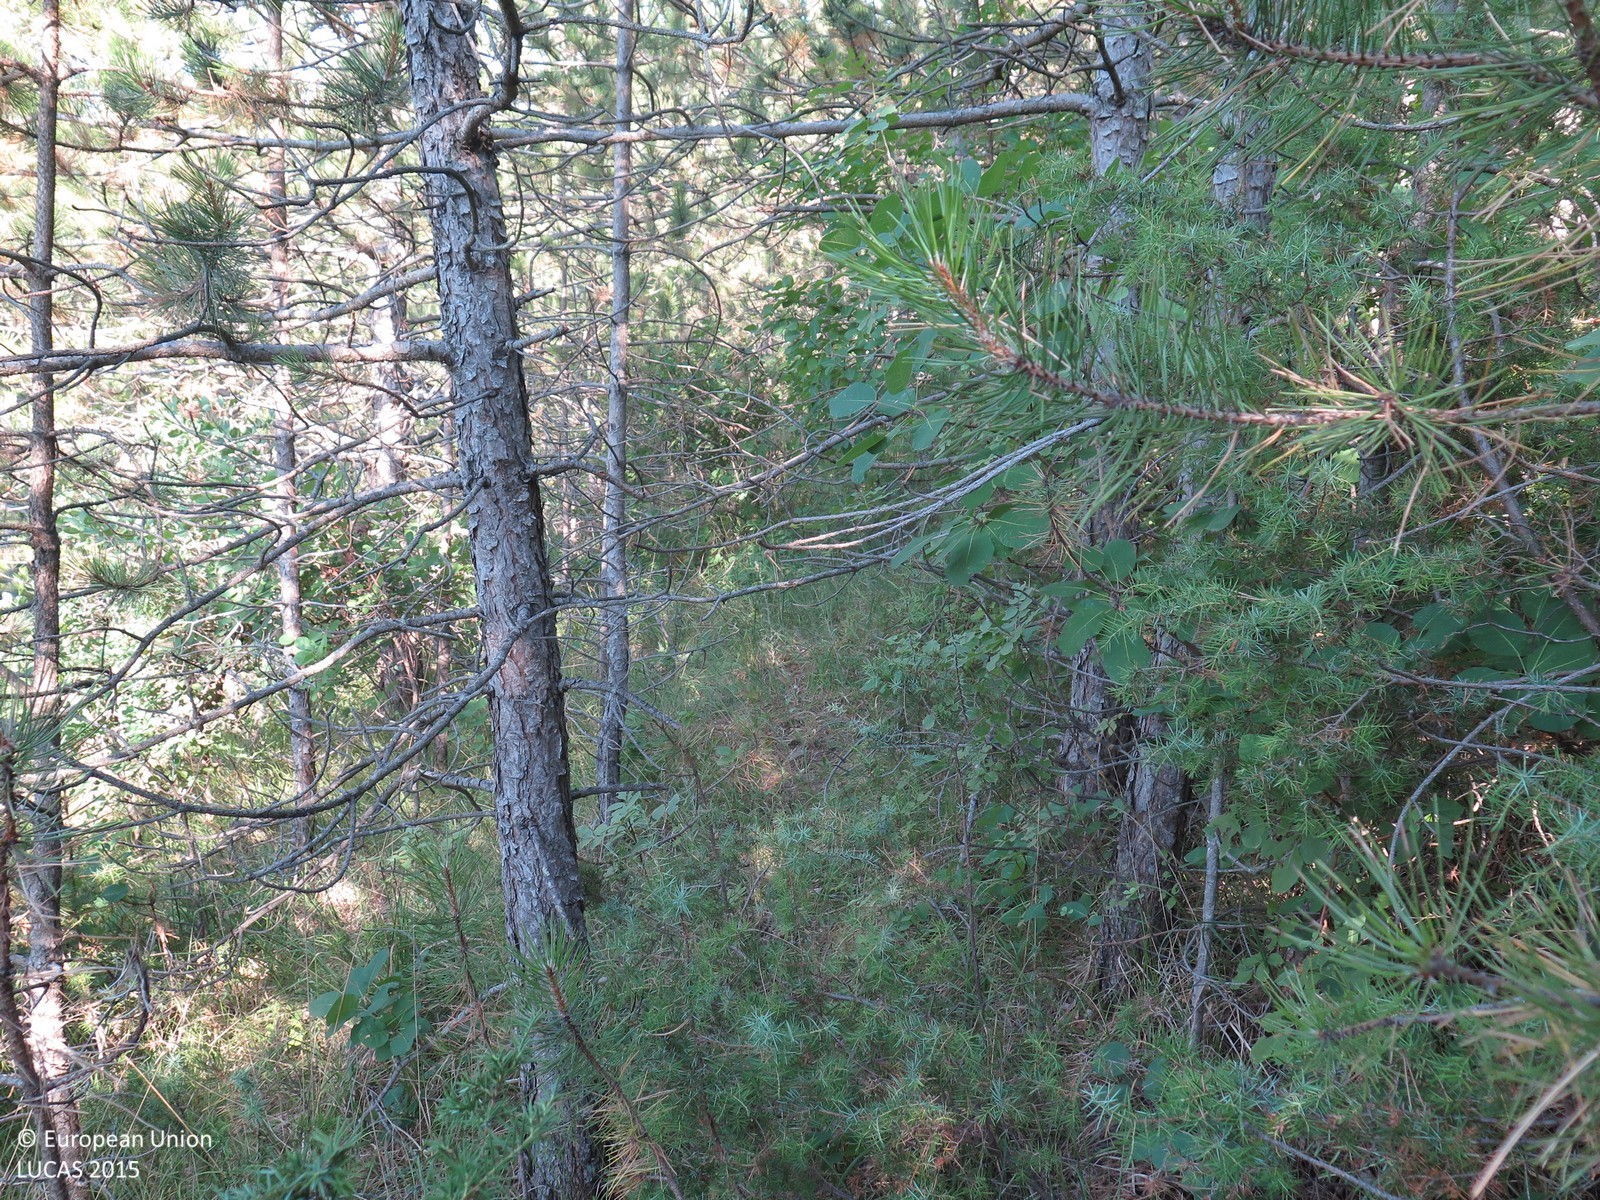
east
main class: Woodland
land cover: Pine dominated coniferous woodland
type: coniferous forest of the mediterranean region
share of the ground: > 75 %
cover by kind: coniferous forest trees 90 %, shrubs 5 %, herbaceous plants 5 %
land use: Semi-natural and natural areas not in use
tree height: > 5 m
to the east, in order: Pine dominated coniferous woodland; Grass margins; Tracks; Grass margins; Broadleaved woodland; Tracks; Broadleaved woodland
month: July
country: HR
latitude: 45.3606
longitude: 13.8887
